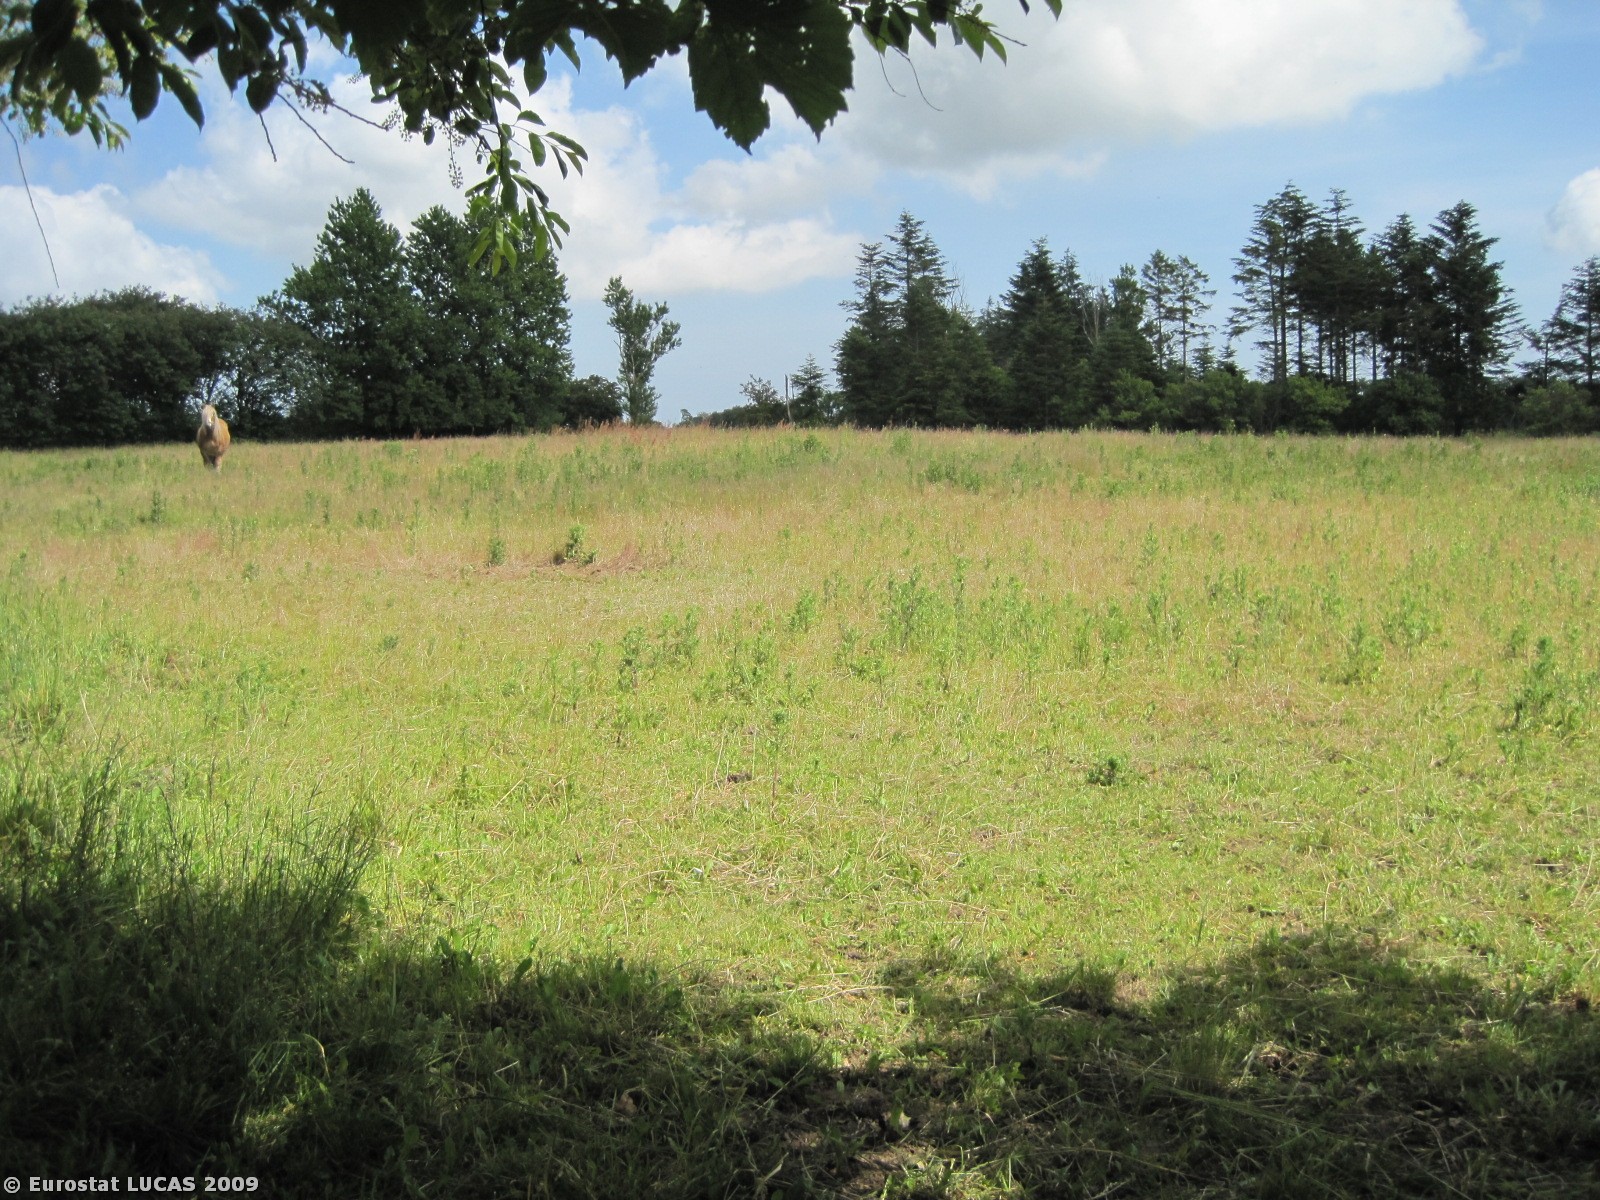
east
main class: Grassland
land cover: Grassland without tree/shrub cover
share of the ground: > 75 %
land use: Agriculture (excluding fallow land and kitchen gardens)
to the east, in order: Grassland without tree/shrub cover; Fences; Mixed woodland; Grass margins; Barley; Grass margins; Mixed woodland; Grass margins; Grassland without tree/shrub cover; Fences; Grassland without tree/shrub cover
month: June
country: DK
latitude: 57.1403
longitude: 10.2145
